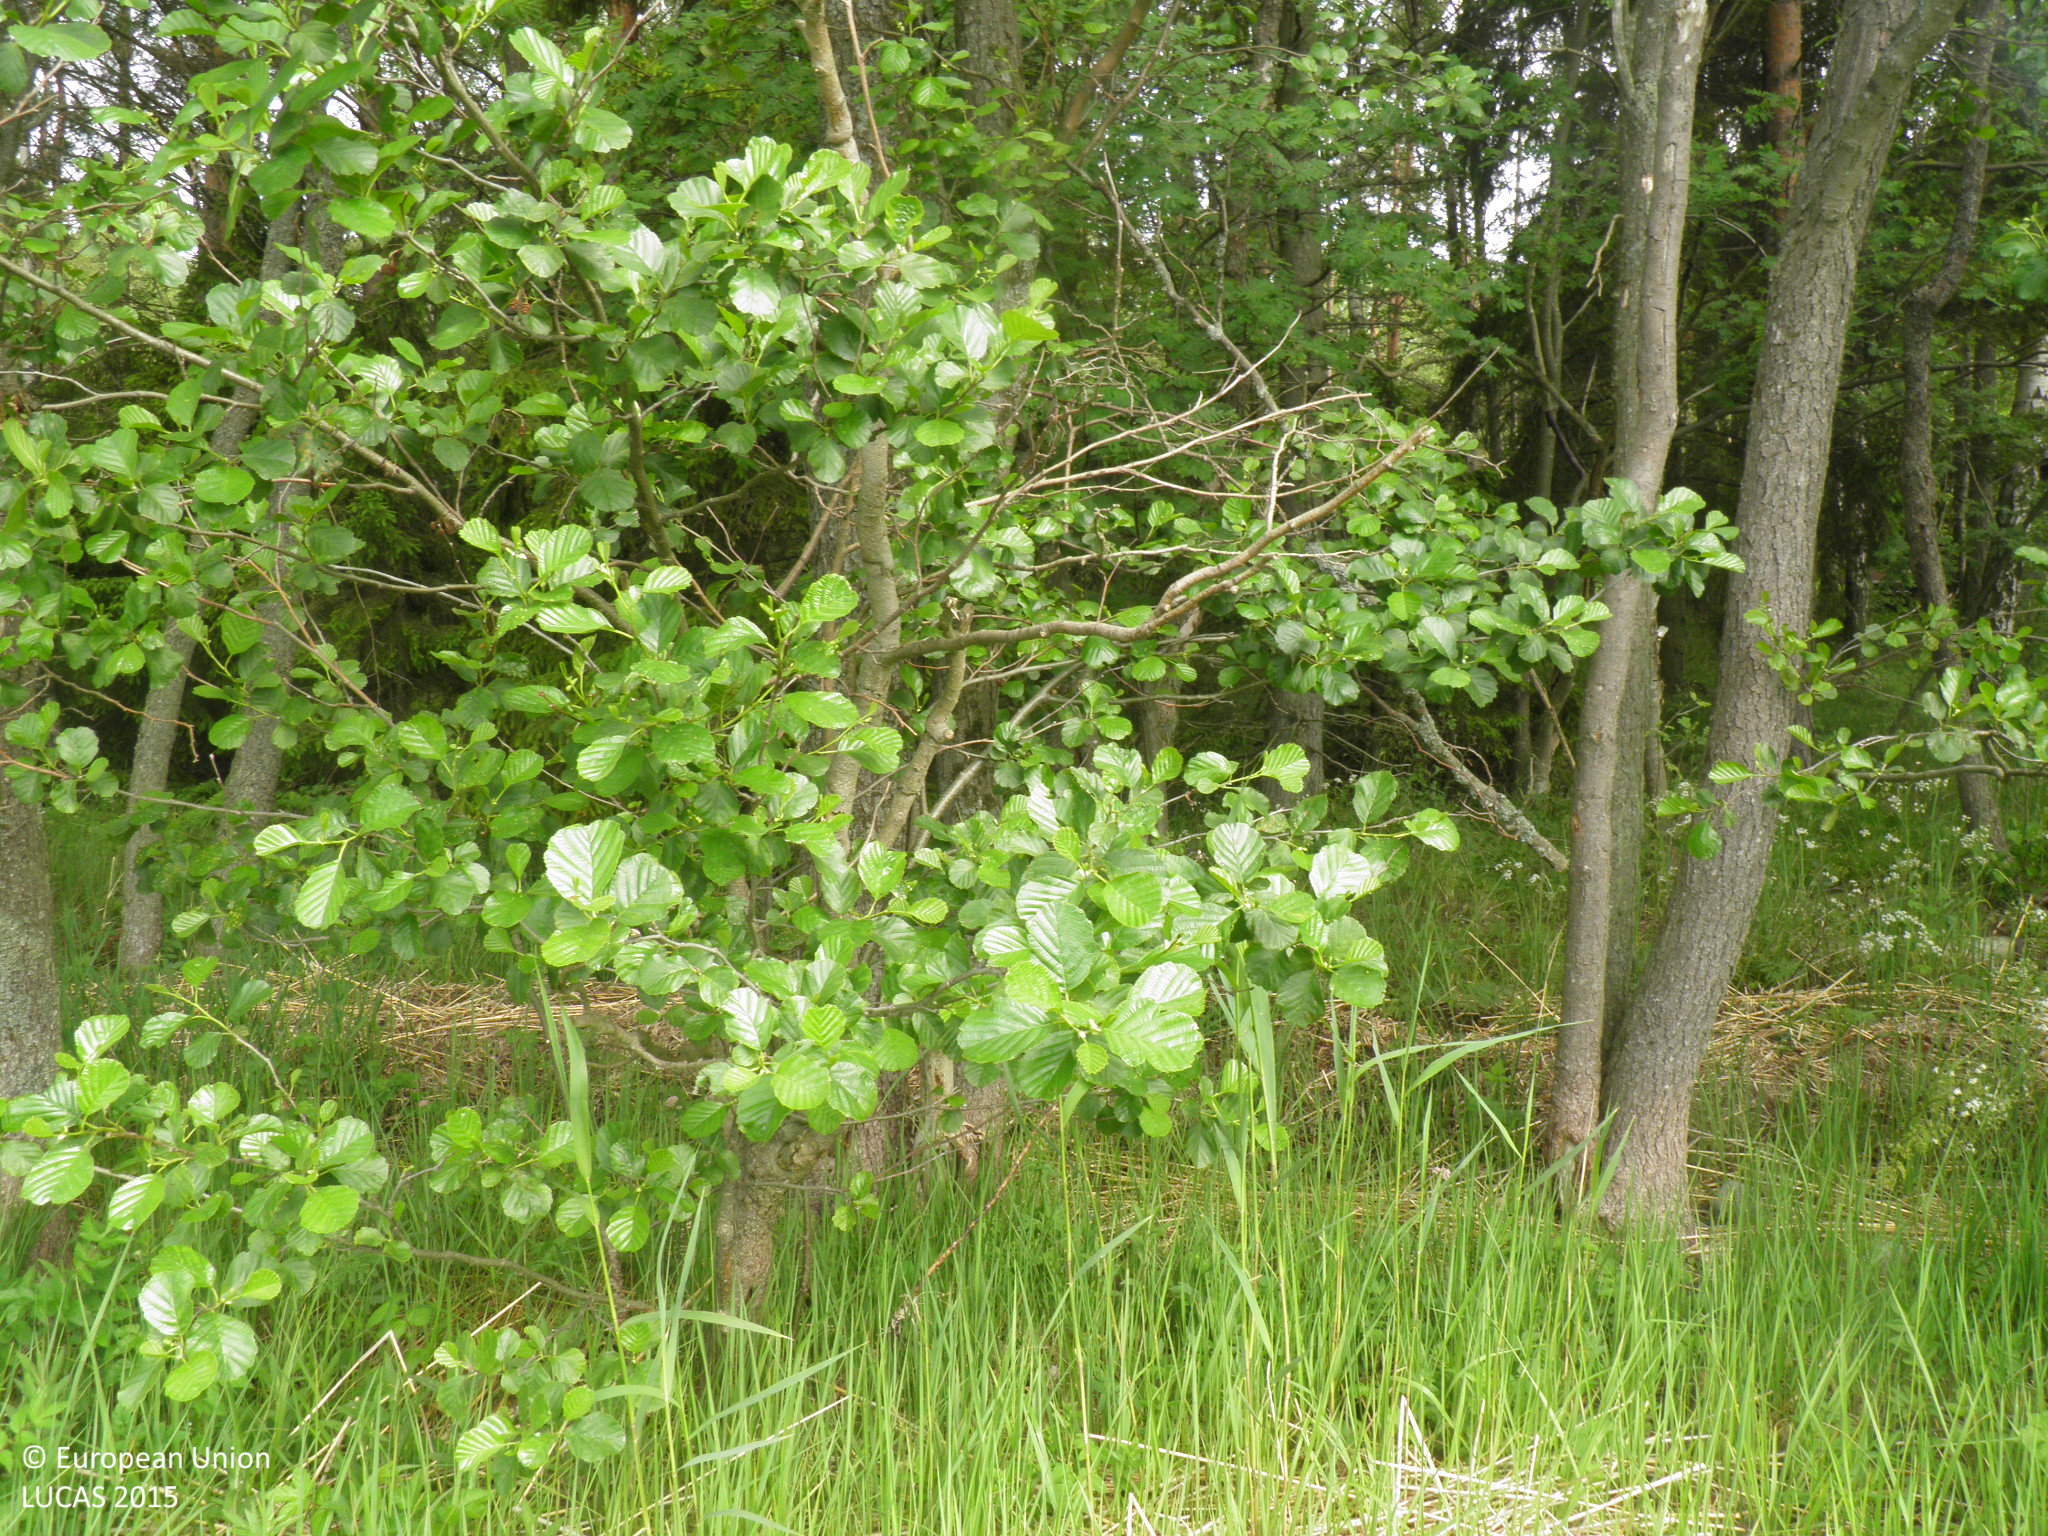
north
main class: Woodland
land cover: Pine dominated coniferous woodland
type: boreal forest
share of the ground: 50 - 75 %
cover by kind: coniferous forest trees 50 %, lichens and mosses 40 %, consolidated bare surface 10 %
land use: Forestry
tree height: > 5 m
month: June
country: FI
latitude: 60.4918
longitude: 21.5052
